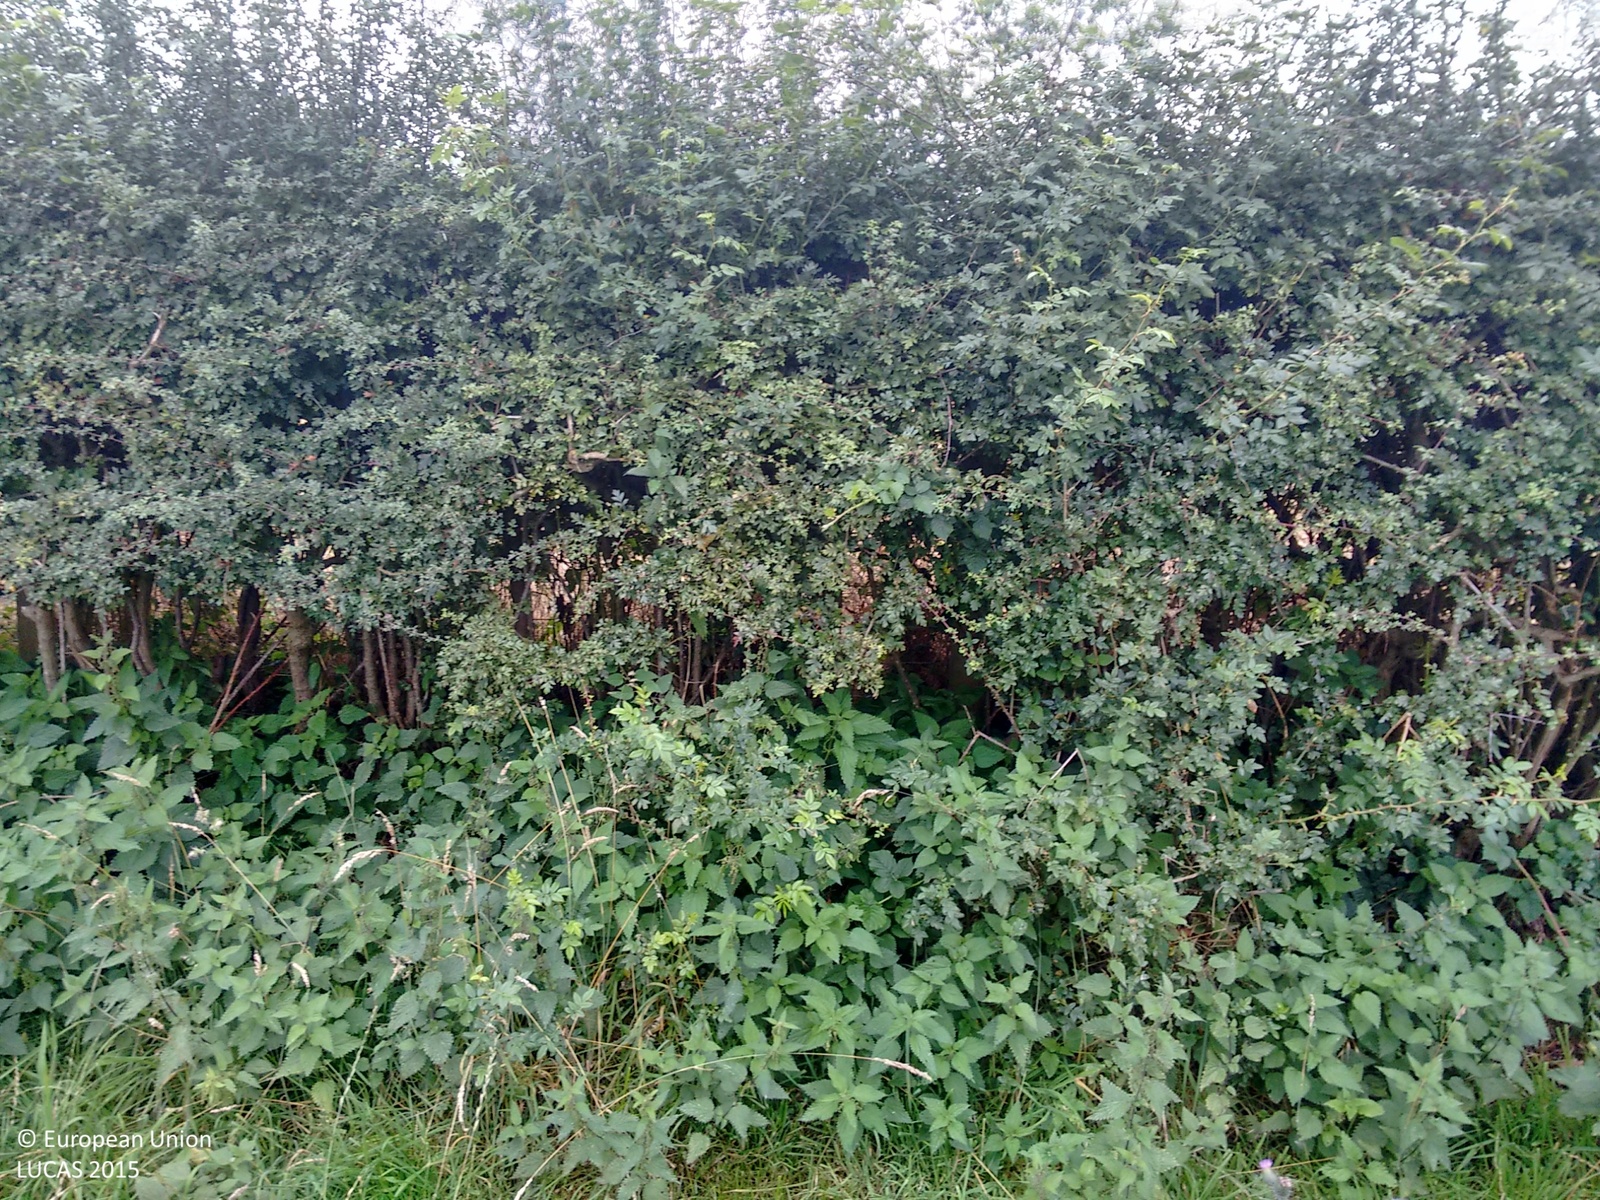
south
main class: Grassland
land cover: Grassland without tree/shrub cover
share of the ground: > 75 %
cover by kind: herbaceous plants 100 %
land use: Agriculture (excluding fallow land and kitchen gardens)
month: September
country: GB
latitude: 52.7140
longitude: -2.8470
